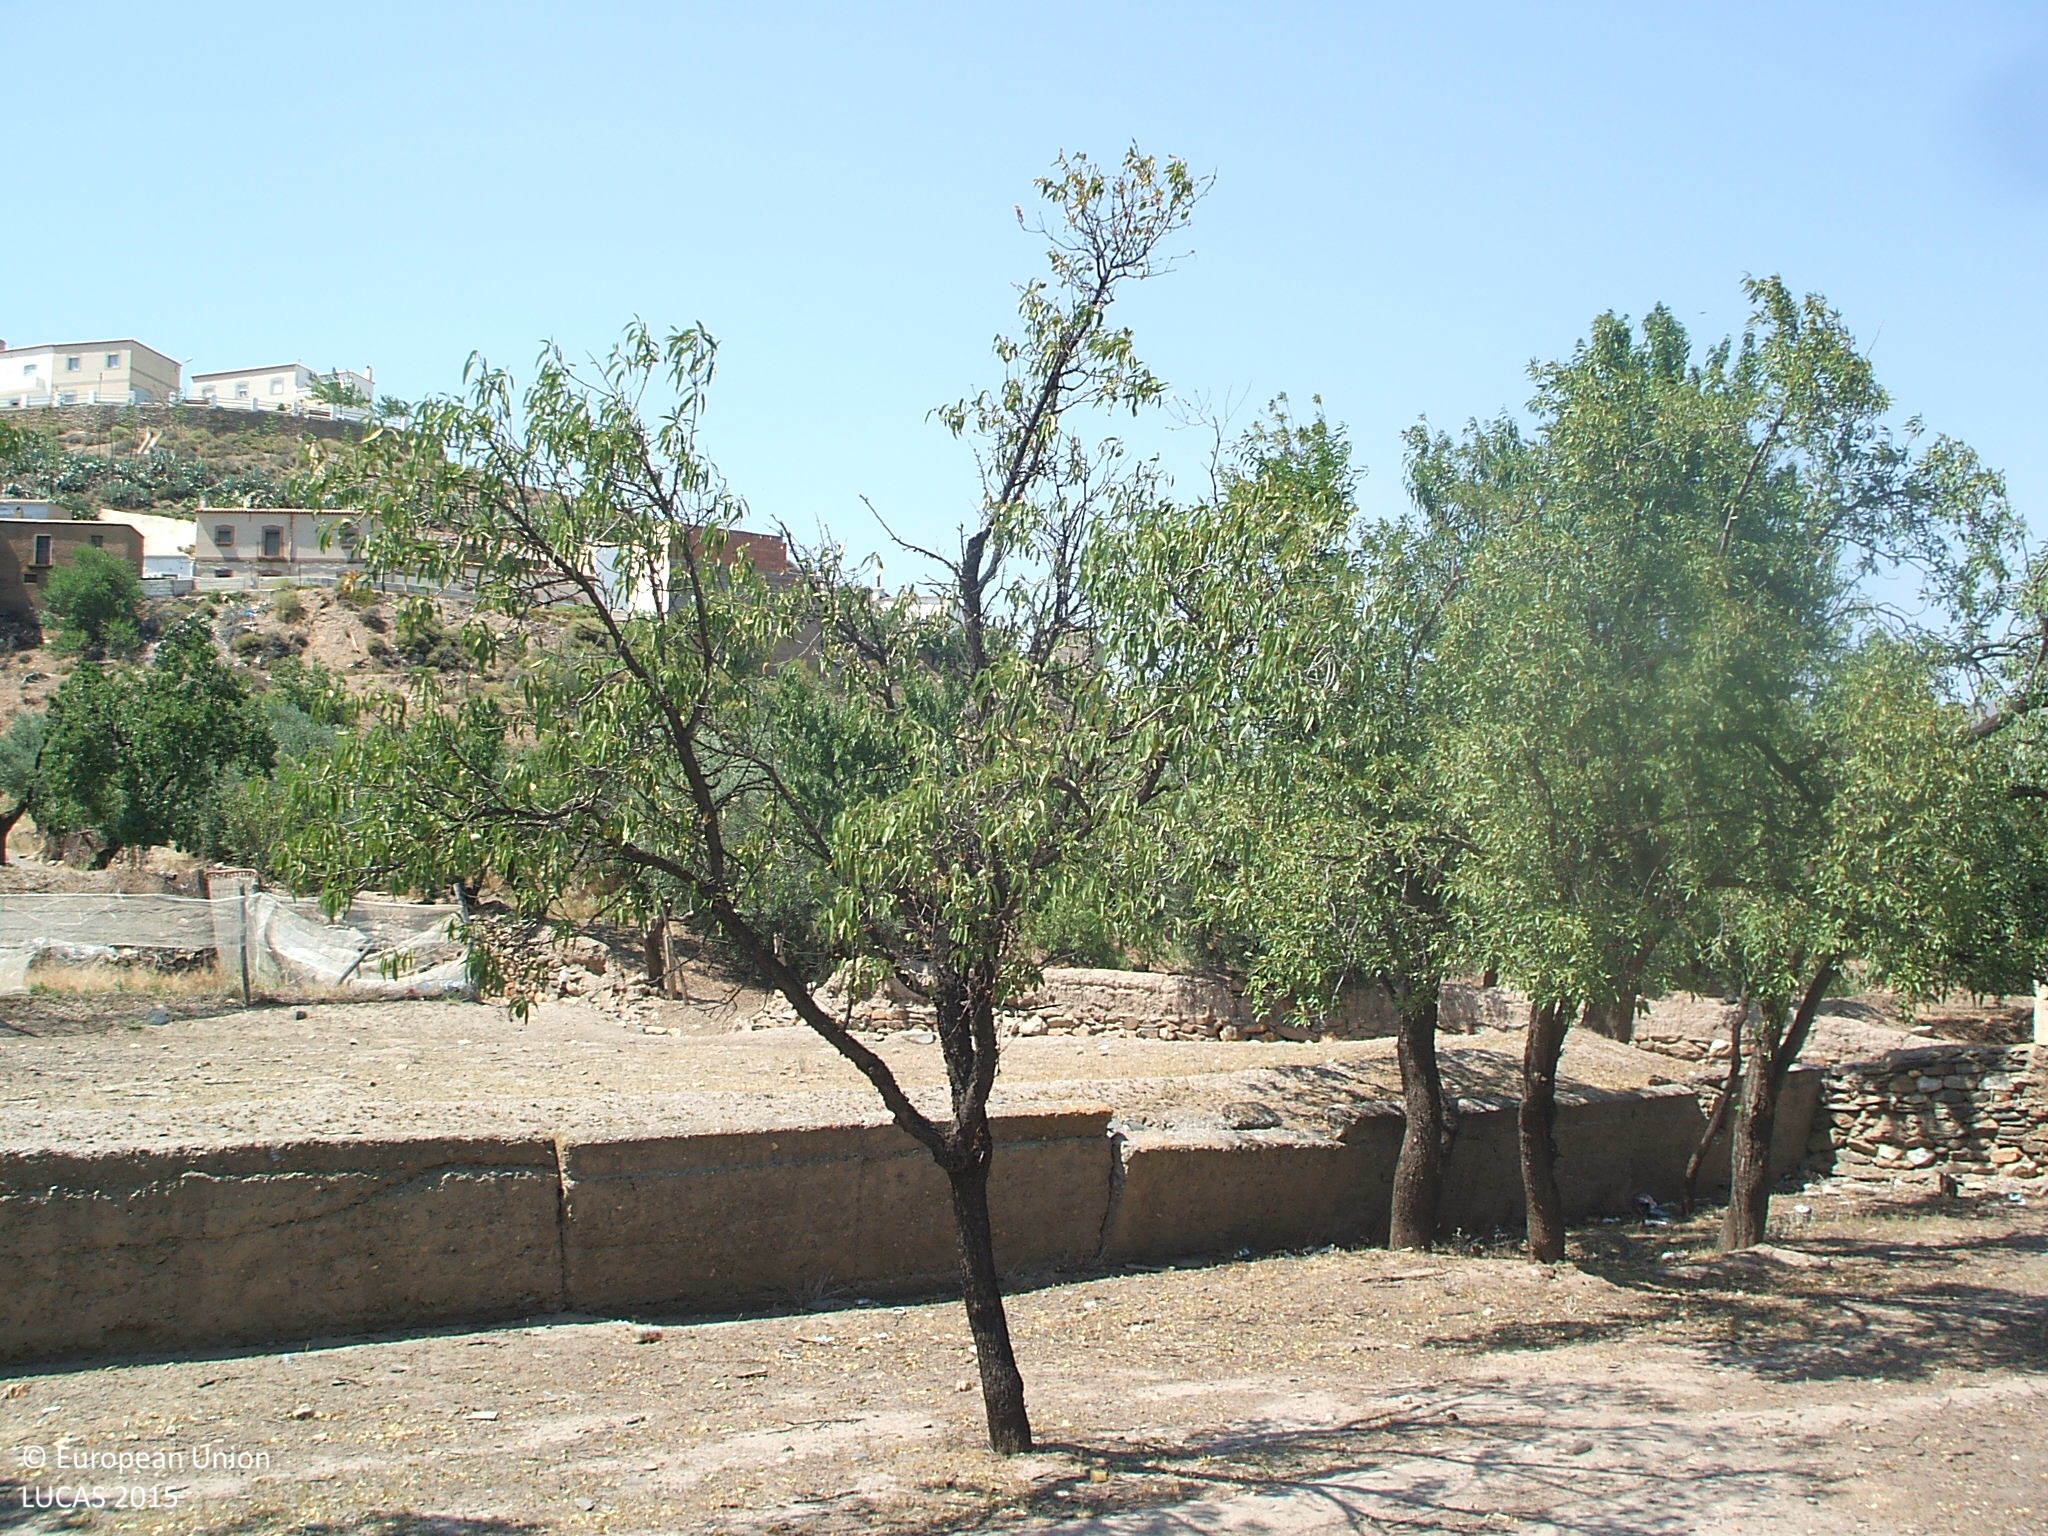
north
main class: Cropland
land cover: Nuts trees
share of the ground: 50 - 75 %
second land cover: Other bare soil
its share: > 75 %
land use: Agriculture (excluding fallow land and kitchen gardens)
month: June
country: ES
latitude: 37.1677
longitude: -2.8324
